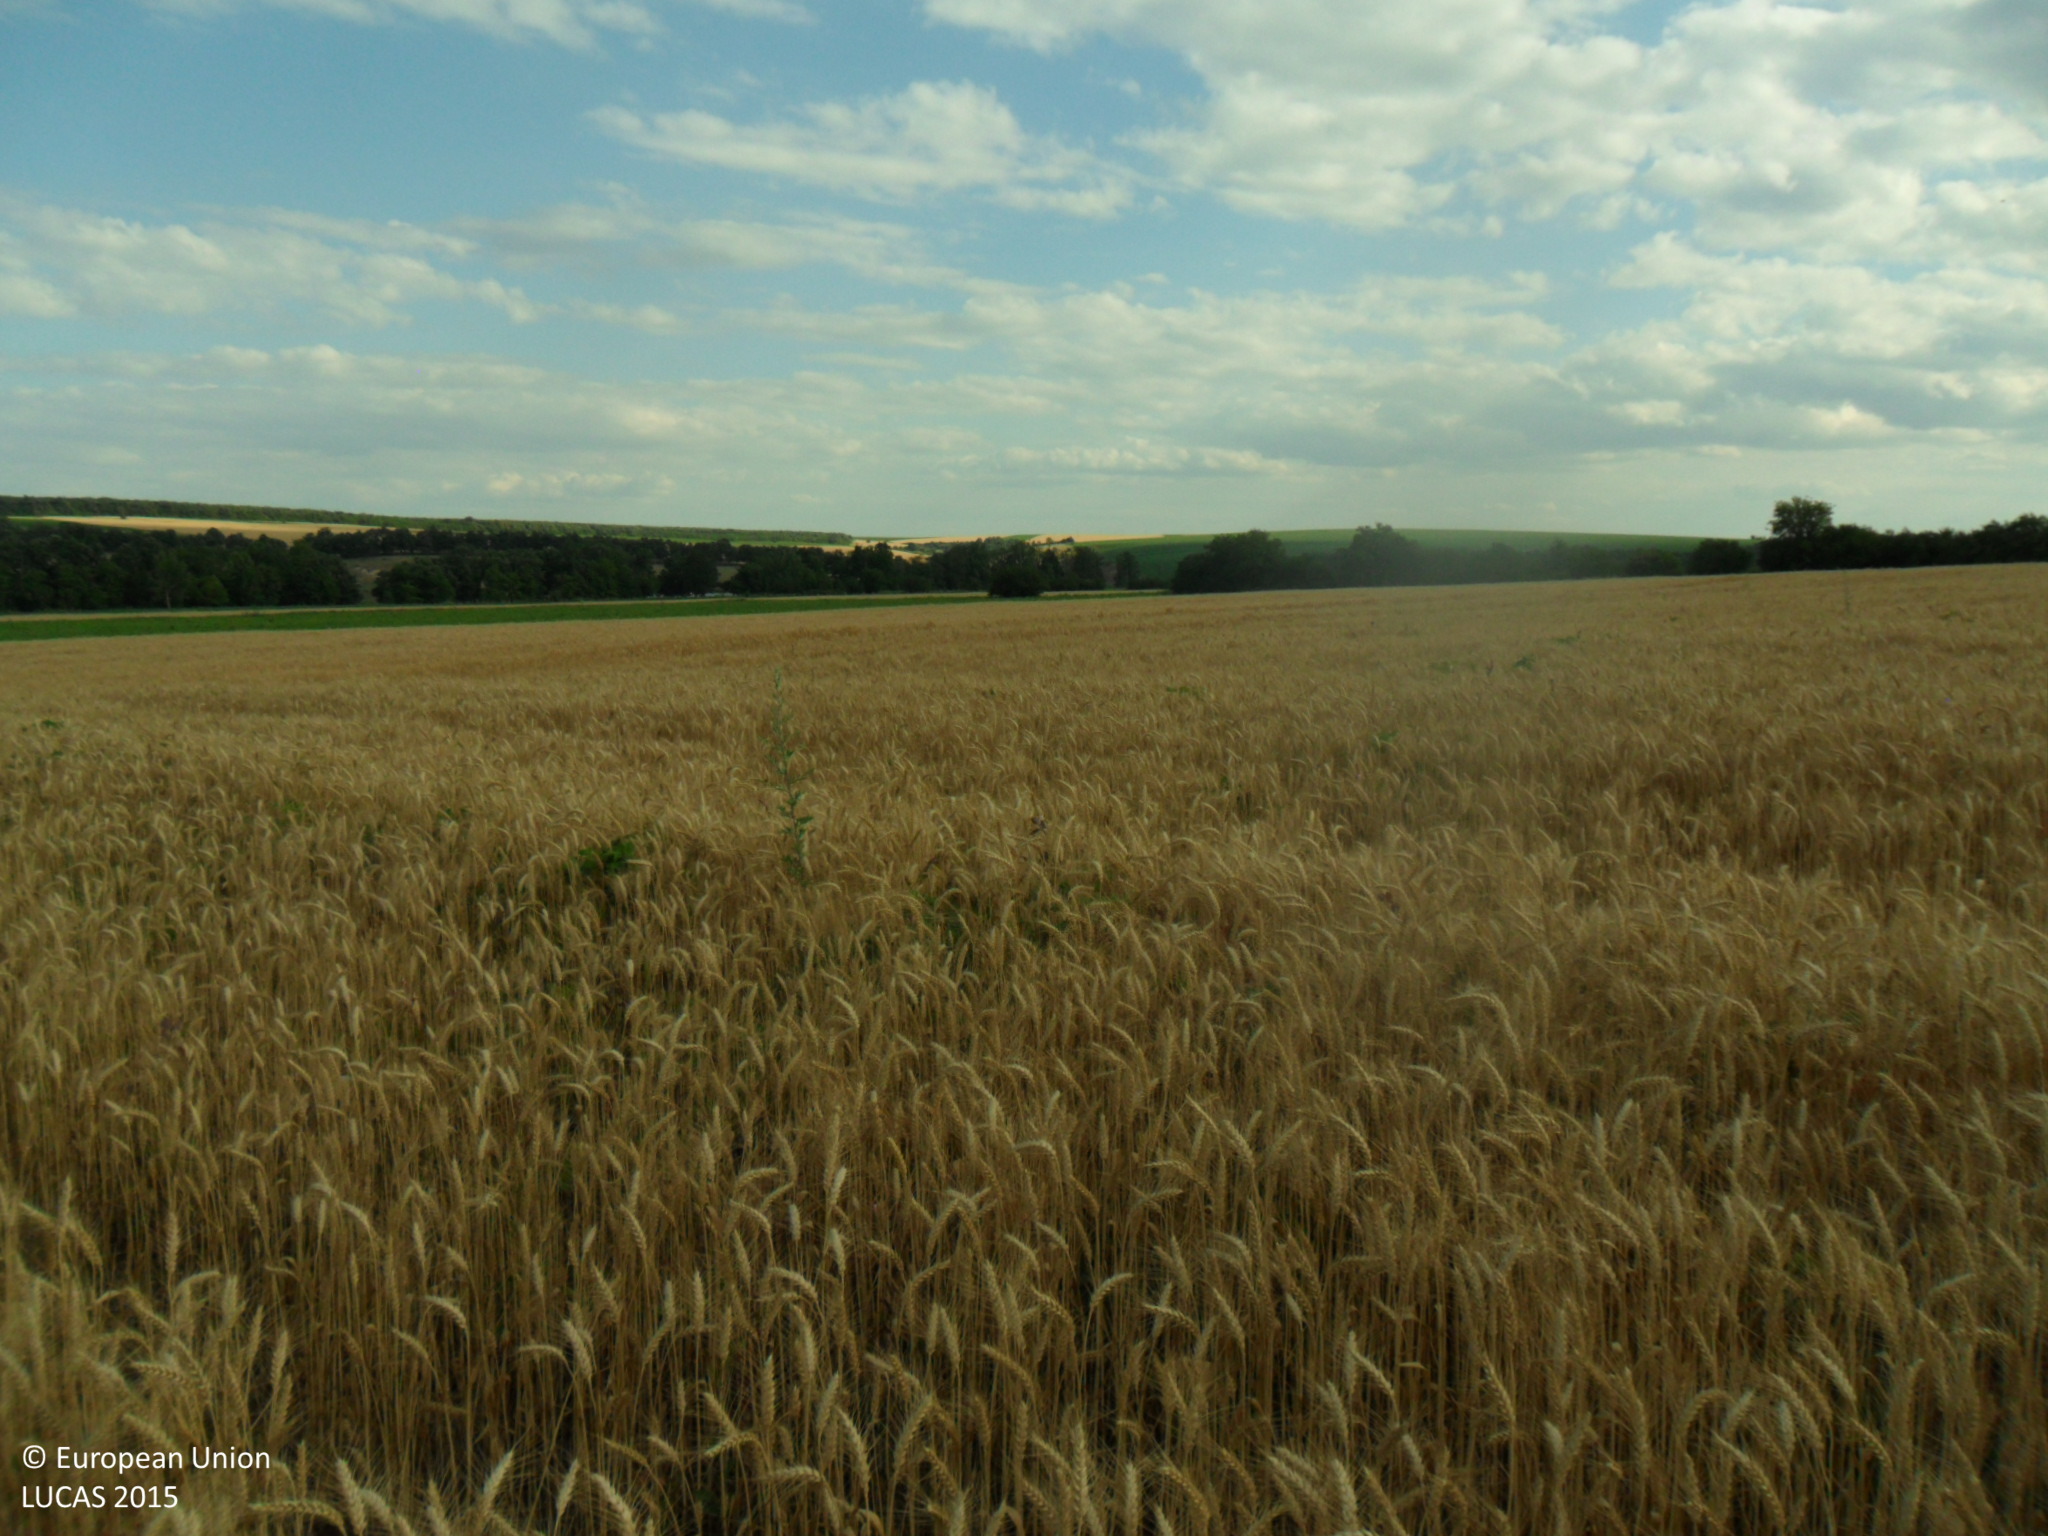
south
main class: Cropland
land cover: Common wheat
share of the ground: > 75 %
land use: Agriculture (excluding fallow land and kitchen gardens)
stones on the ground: < 10 %
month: June
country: BG
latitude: 43.5305
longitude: 27.2879
